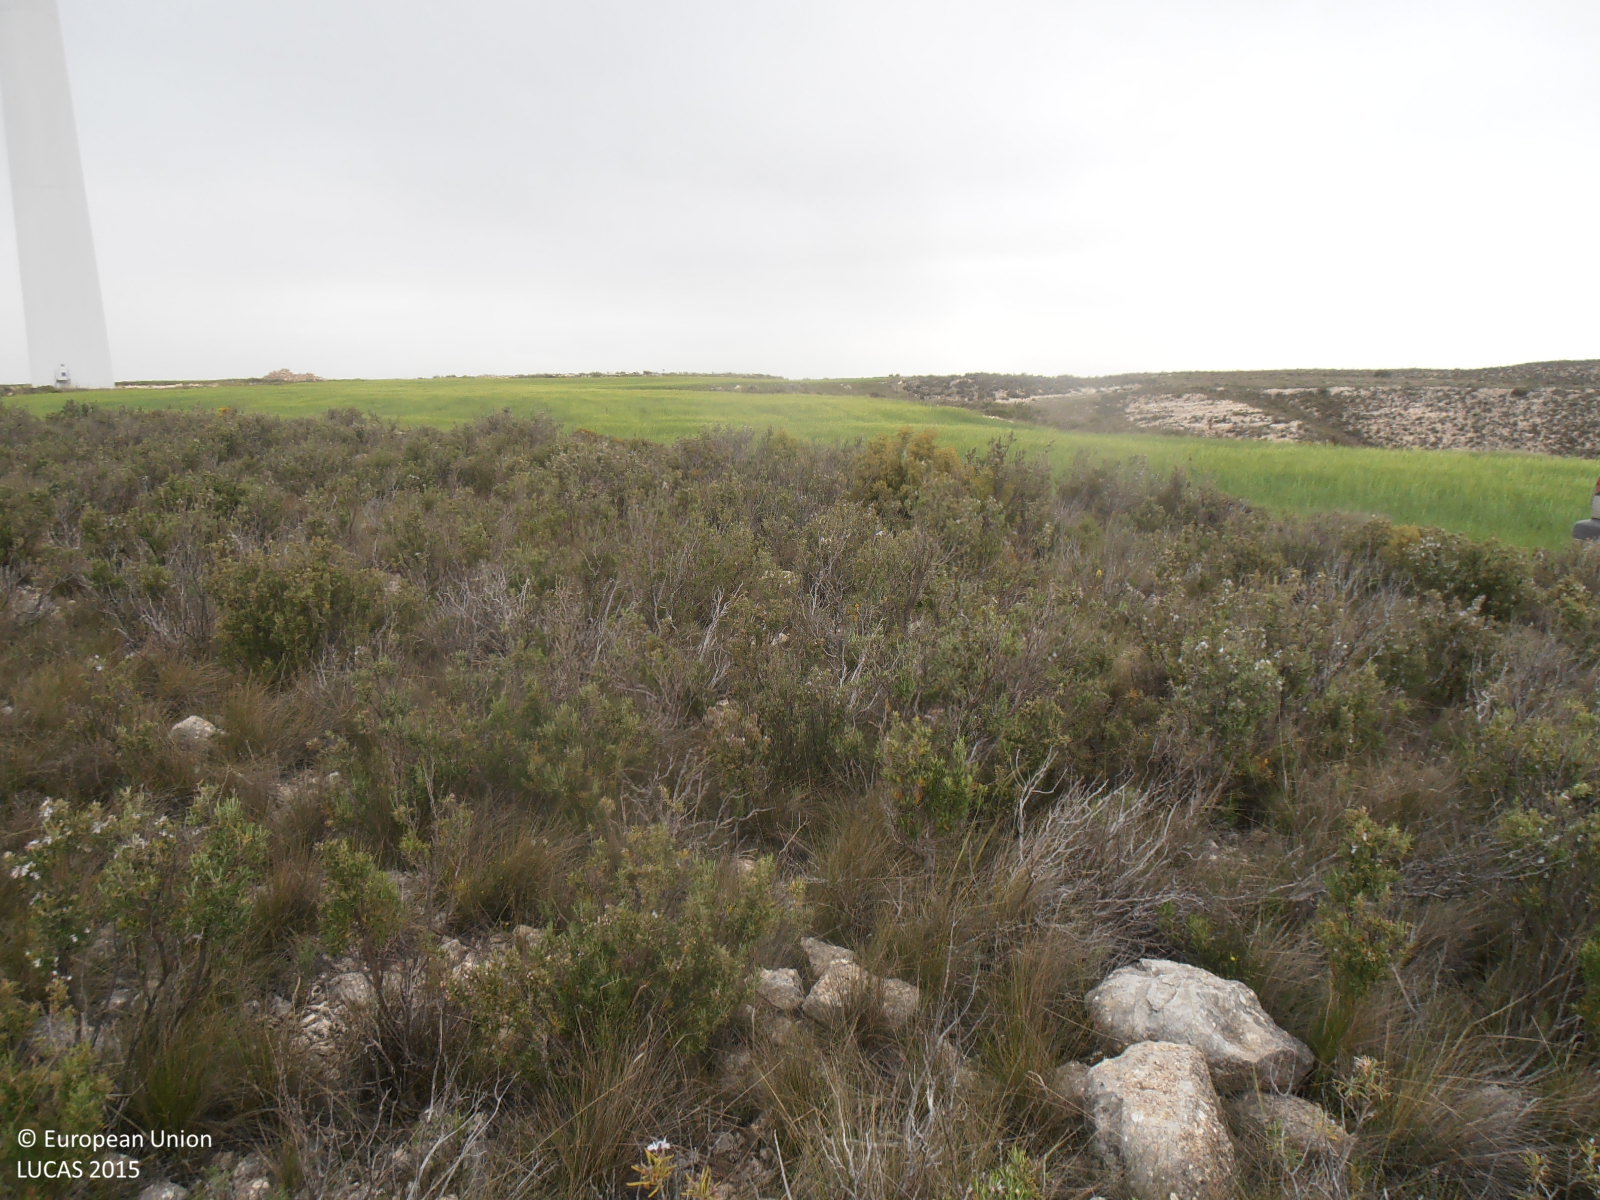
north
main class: Shrubland
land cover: Shrubland without tree cover
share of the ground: > 75 %
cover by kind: shrubs 90 %, herbaceous plants 10 %
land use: Semi-natural and natural areas not in use
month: May
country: ES
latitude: 41.4495
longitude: -1.0216
